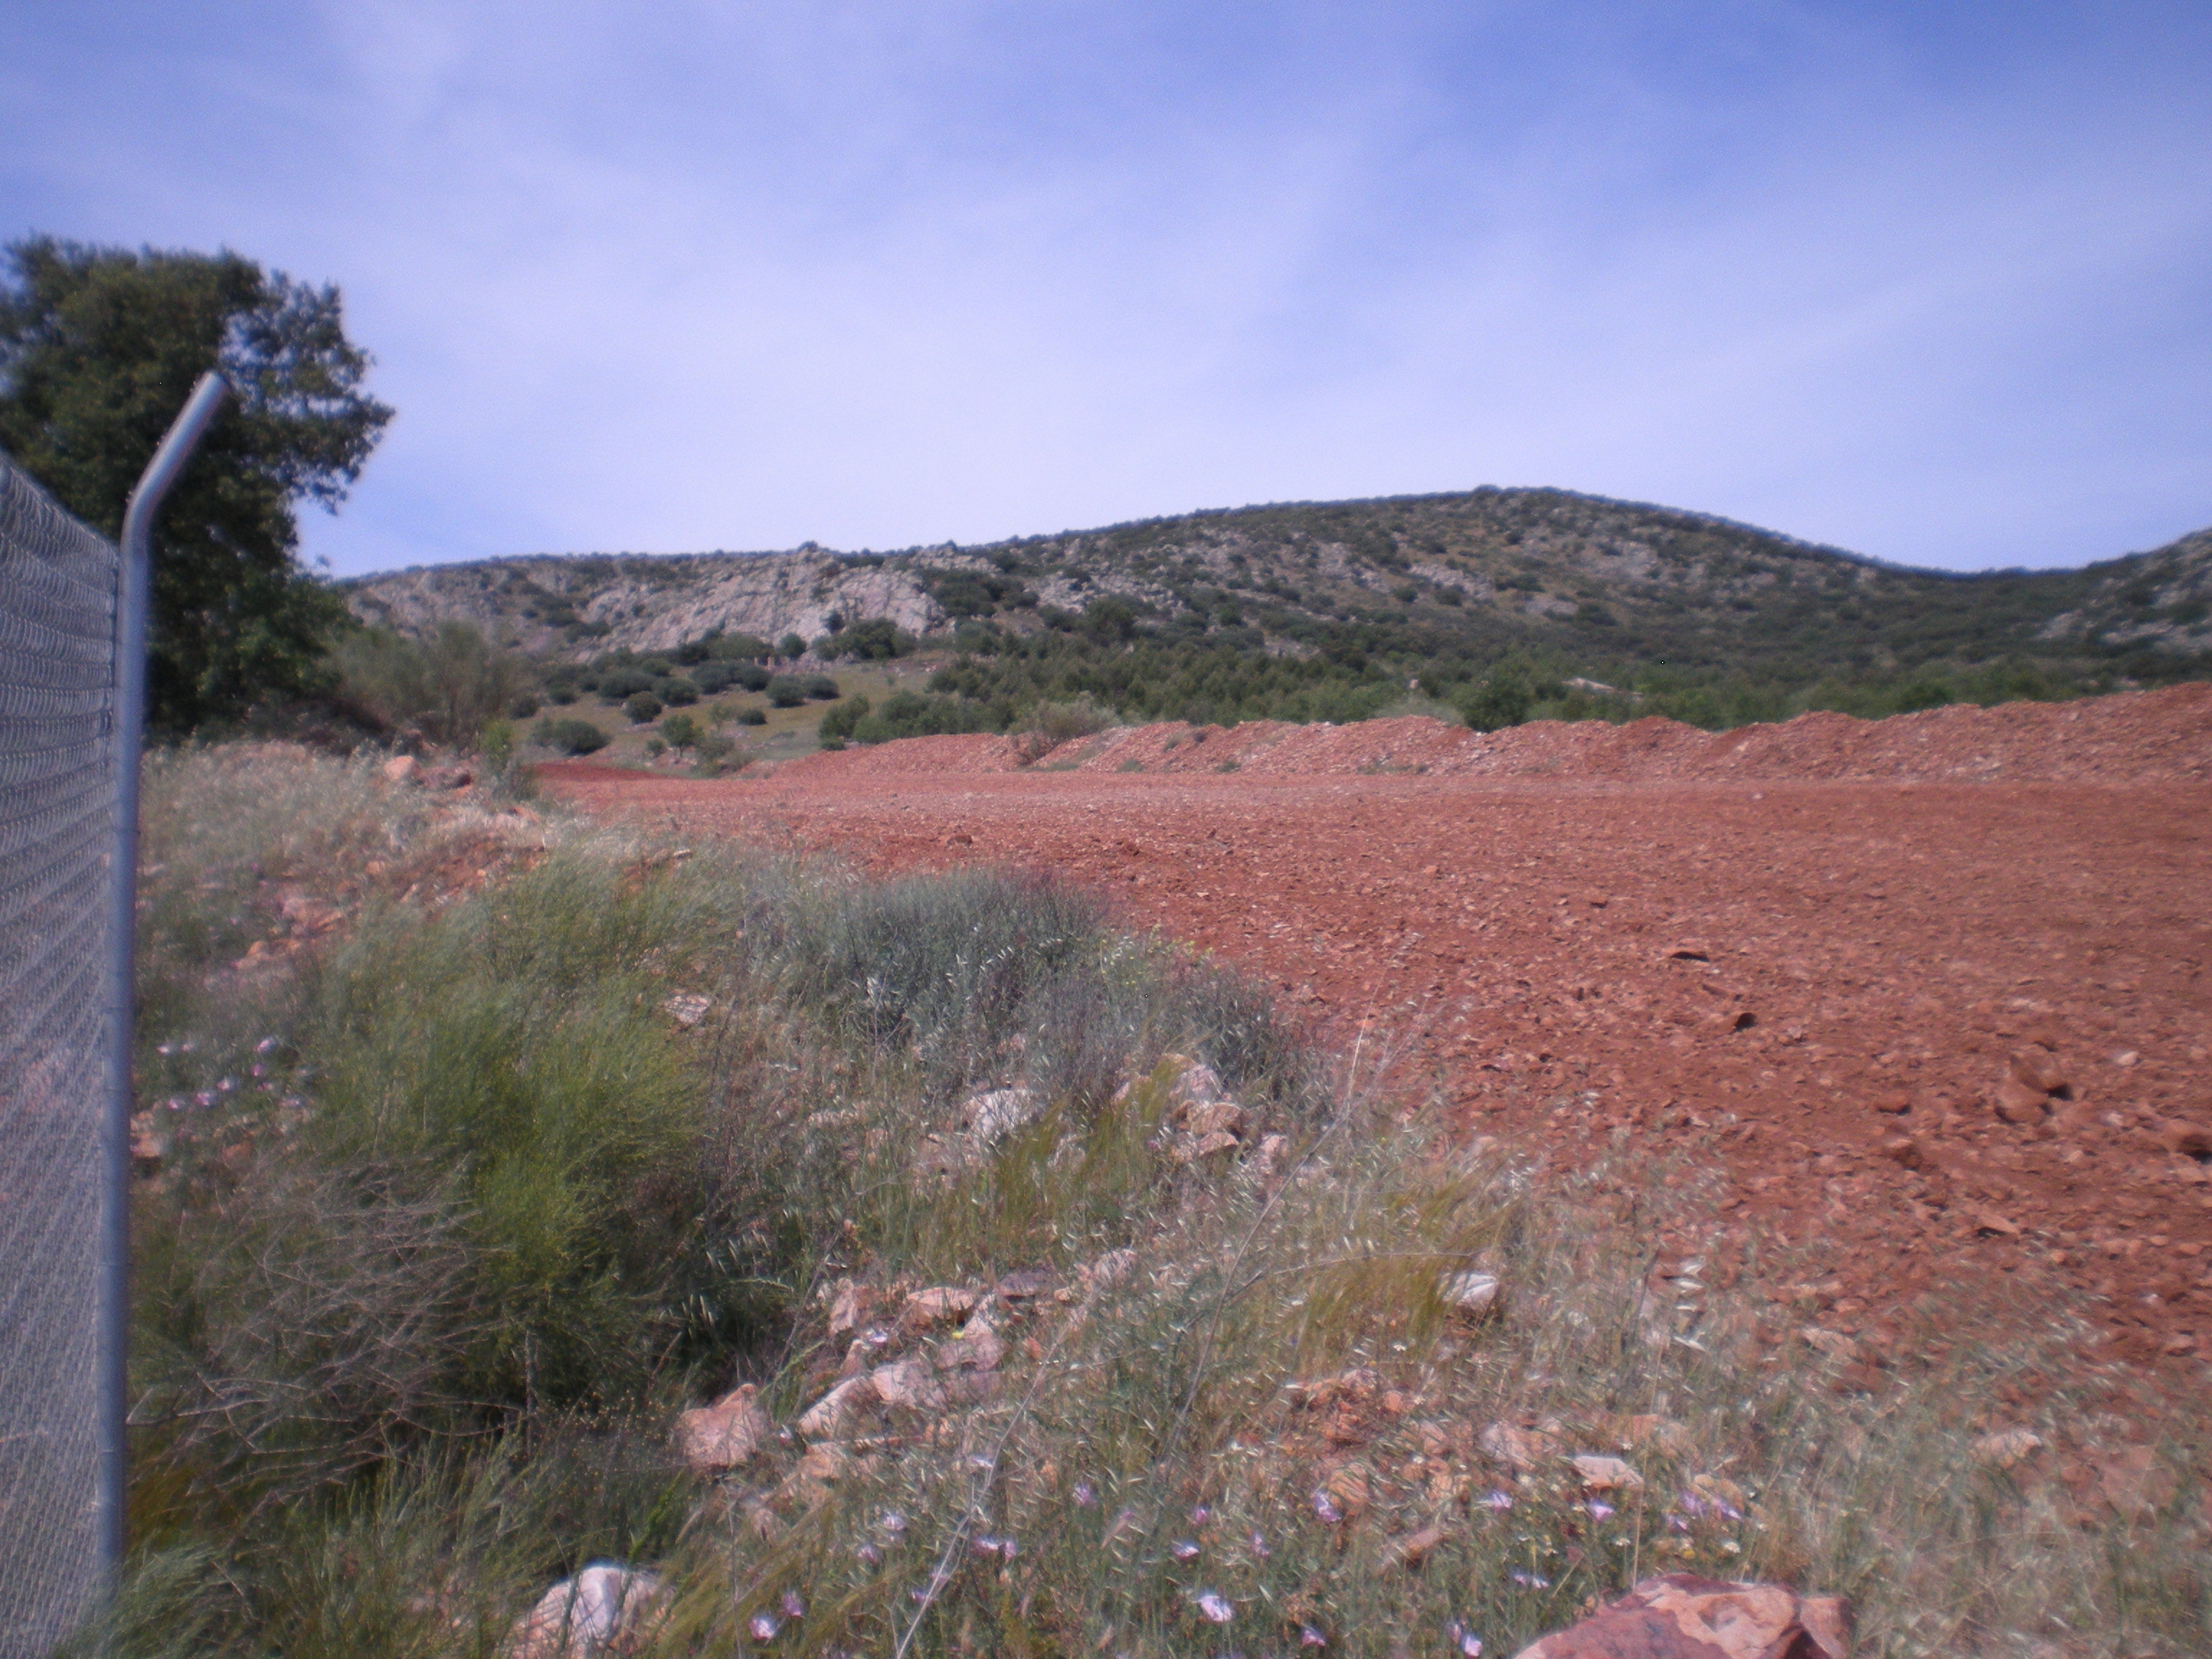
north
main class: Cropland
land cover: Olive groves
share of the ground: < 10 %
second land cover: Spontaneously vegetated surfaces
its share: 10 - 25 %
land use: Agriculture (excluding fallow land and kitchen gardens)
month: May
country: ES
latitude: 38.8279
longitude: -3.5484
